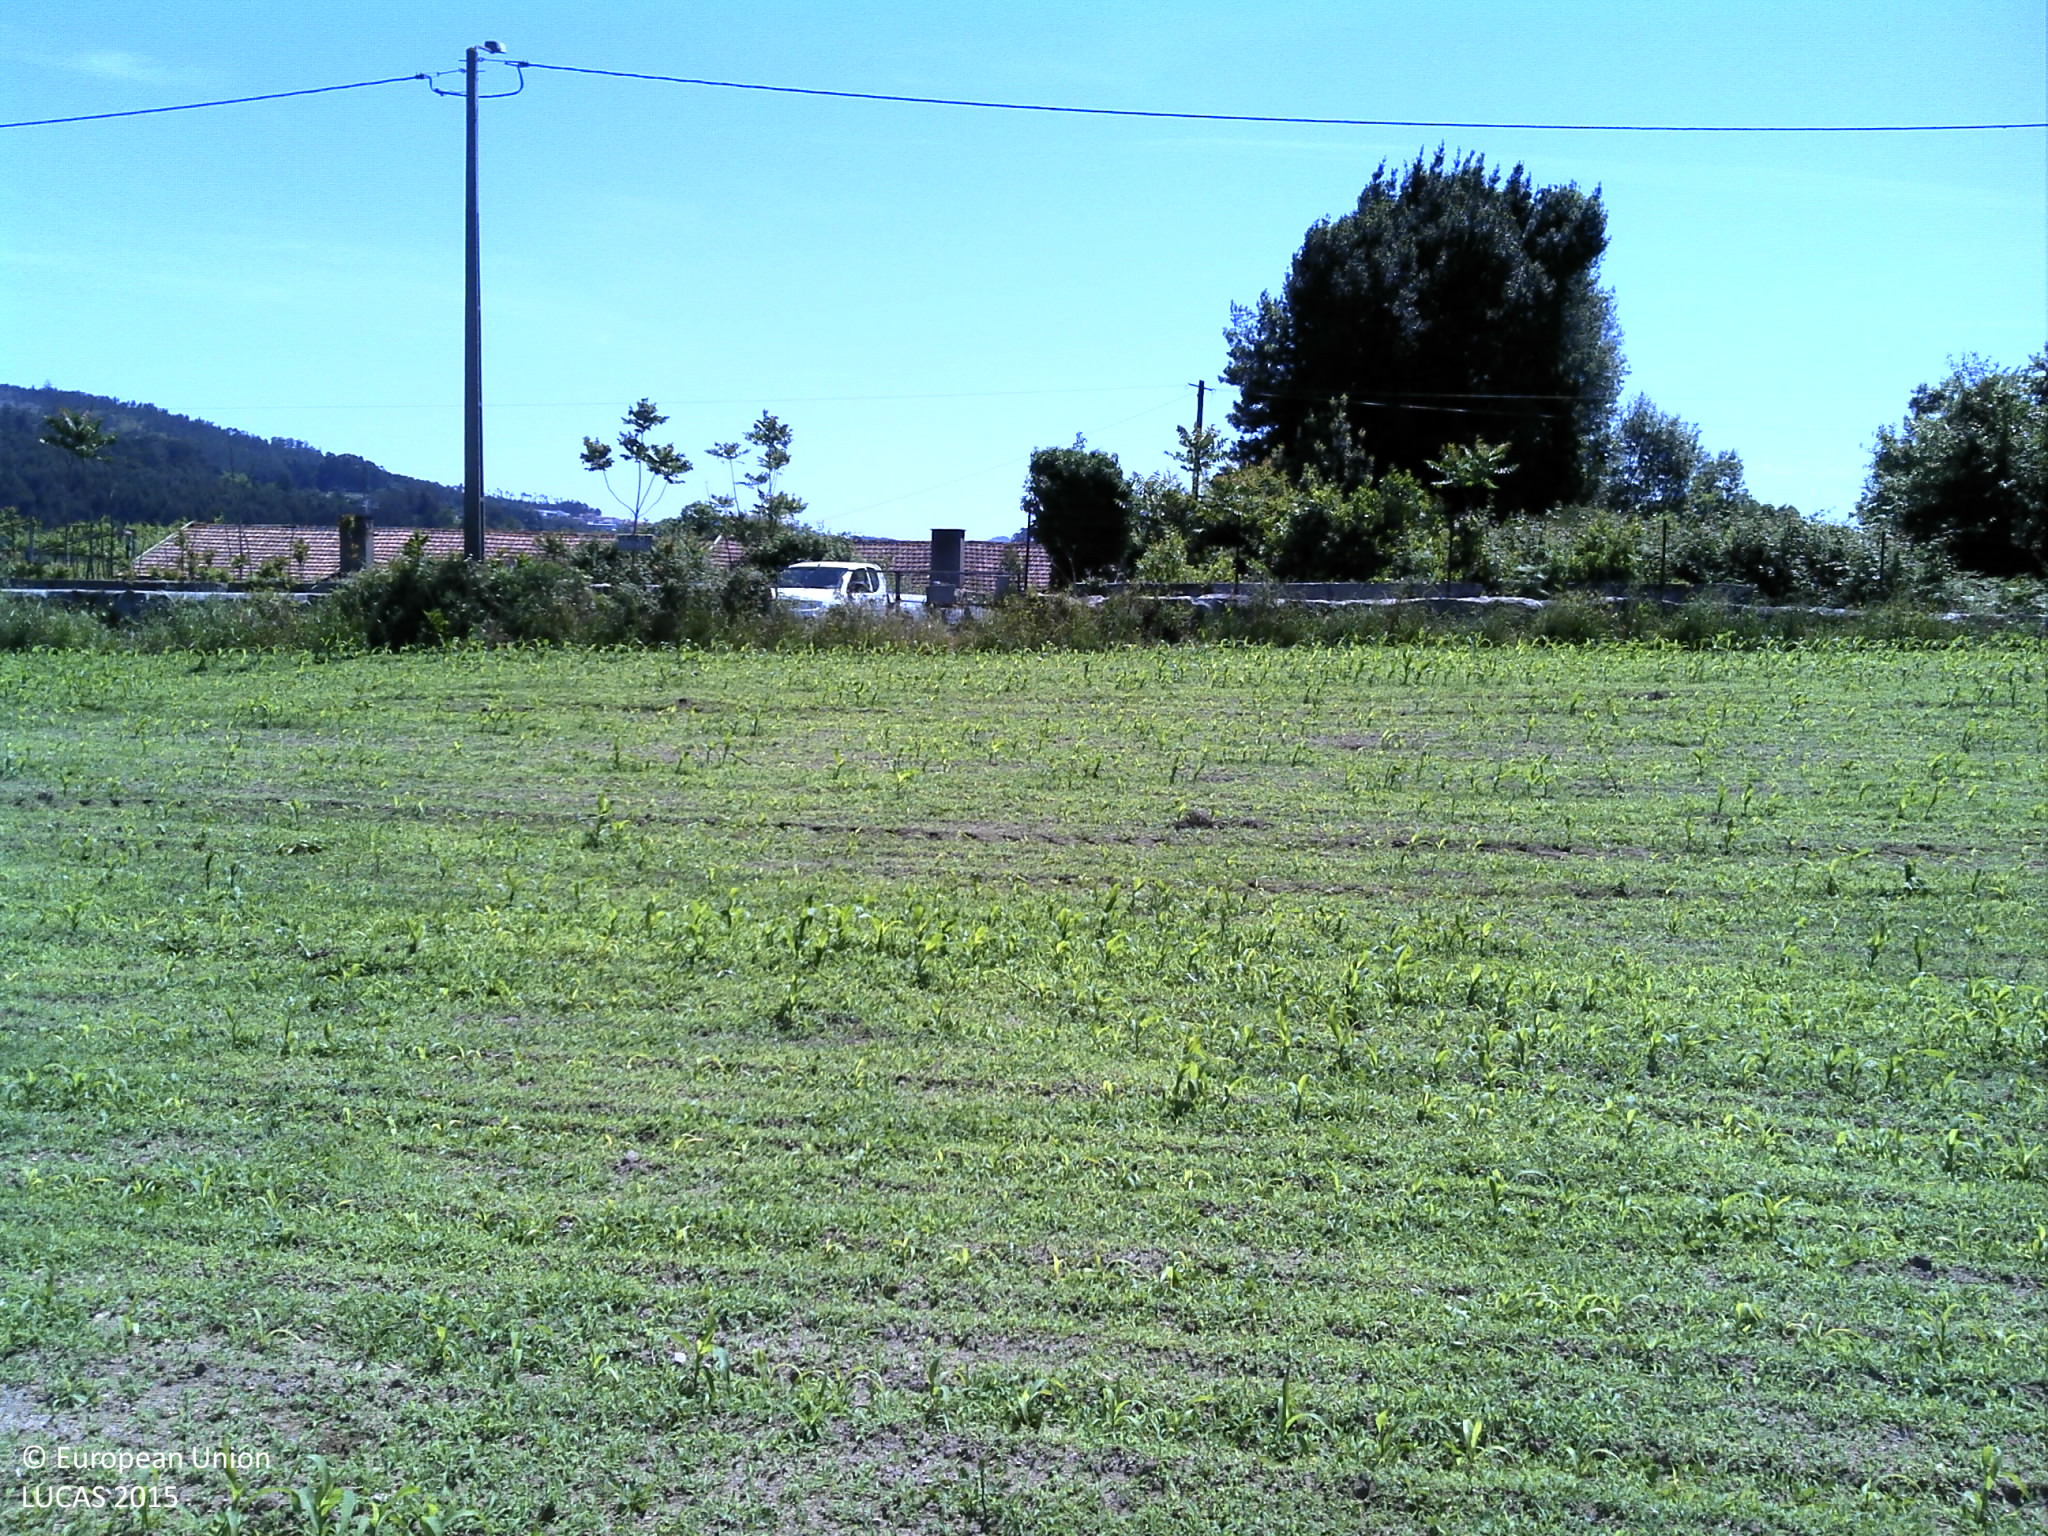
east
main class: Cropland
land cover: Maize
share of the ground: < 10 %
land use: Agriculture (excluding fallow land and kitchen gardens)
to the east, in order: Maize; Electric lines; Dry stone walls; Paved roads, cycling and walking lanes; Dry stone walls; Shrubland without tree cover; Electric lines; Shrubland without tree cover; Artificial constructions in urban areas; Other fresh vegetables; Fences; Grassland without tree/shrub cover; Broadleaved woodland; Grassland without tree/shrub cover; Artificial constructions in urban areas
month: May
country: PT
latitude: 41.4138
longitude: -8.4938
